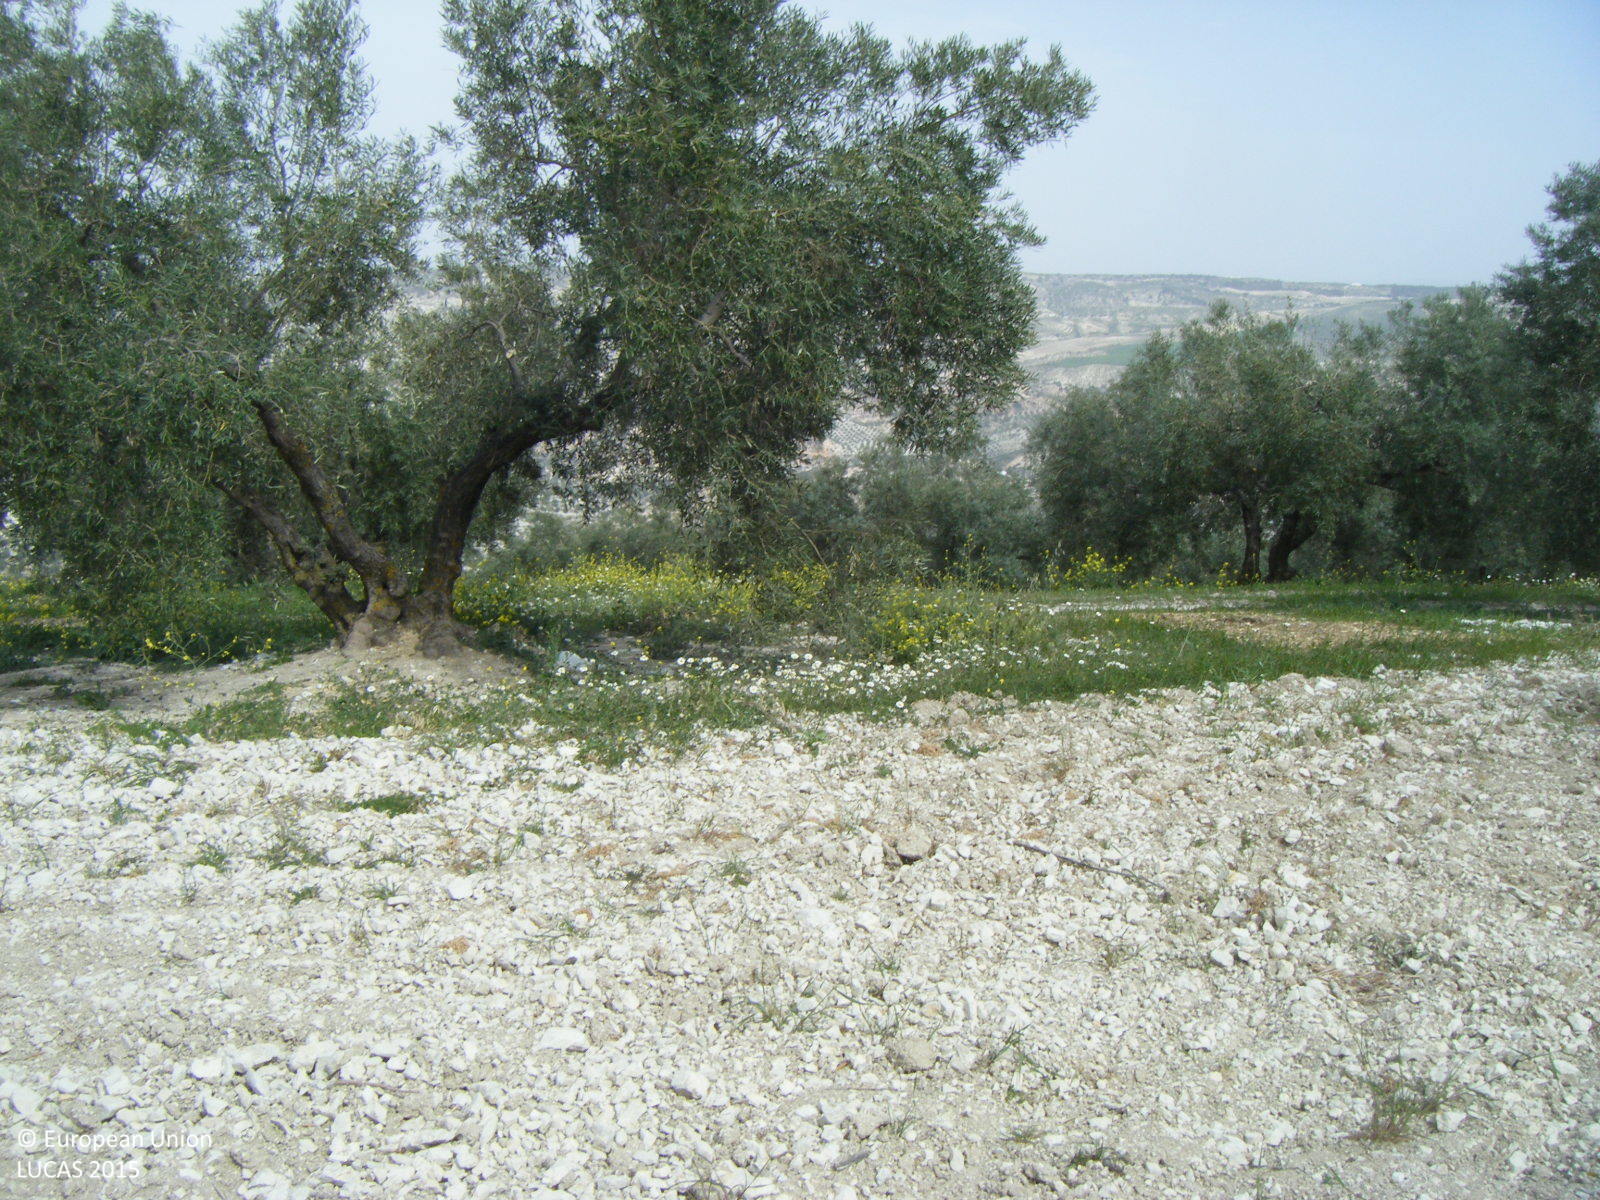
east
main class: Cropland
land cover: Olive groves
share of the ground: 10 - 25 %
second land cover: Other bare soil
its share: > 75 %
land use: Agriculture (excluding fallow land and kitchen gardens)
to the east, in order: Olive groves; Other bare soil
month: April
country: ES
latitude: 37.1003
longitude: -4.0687
